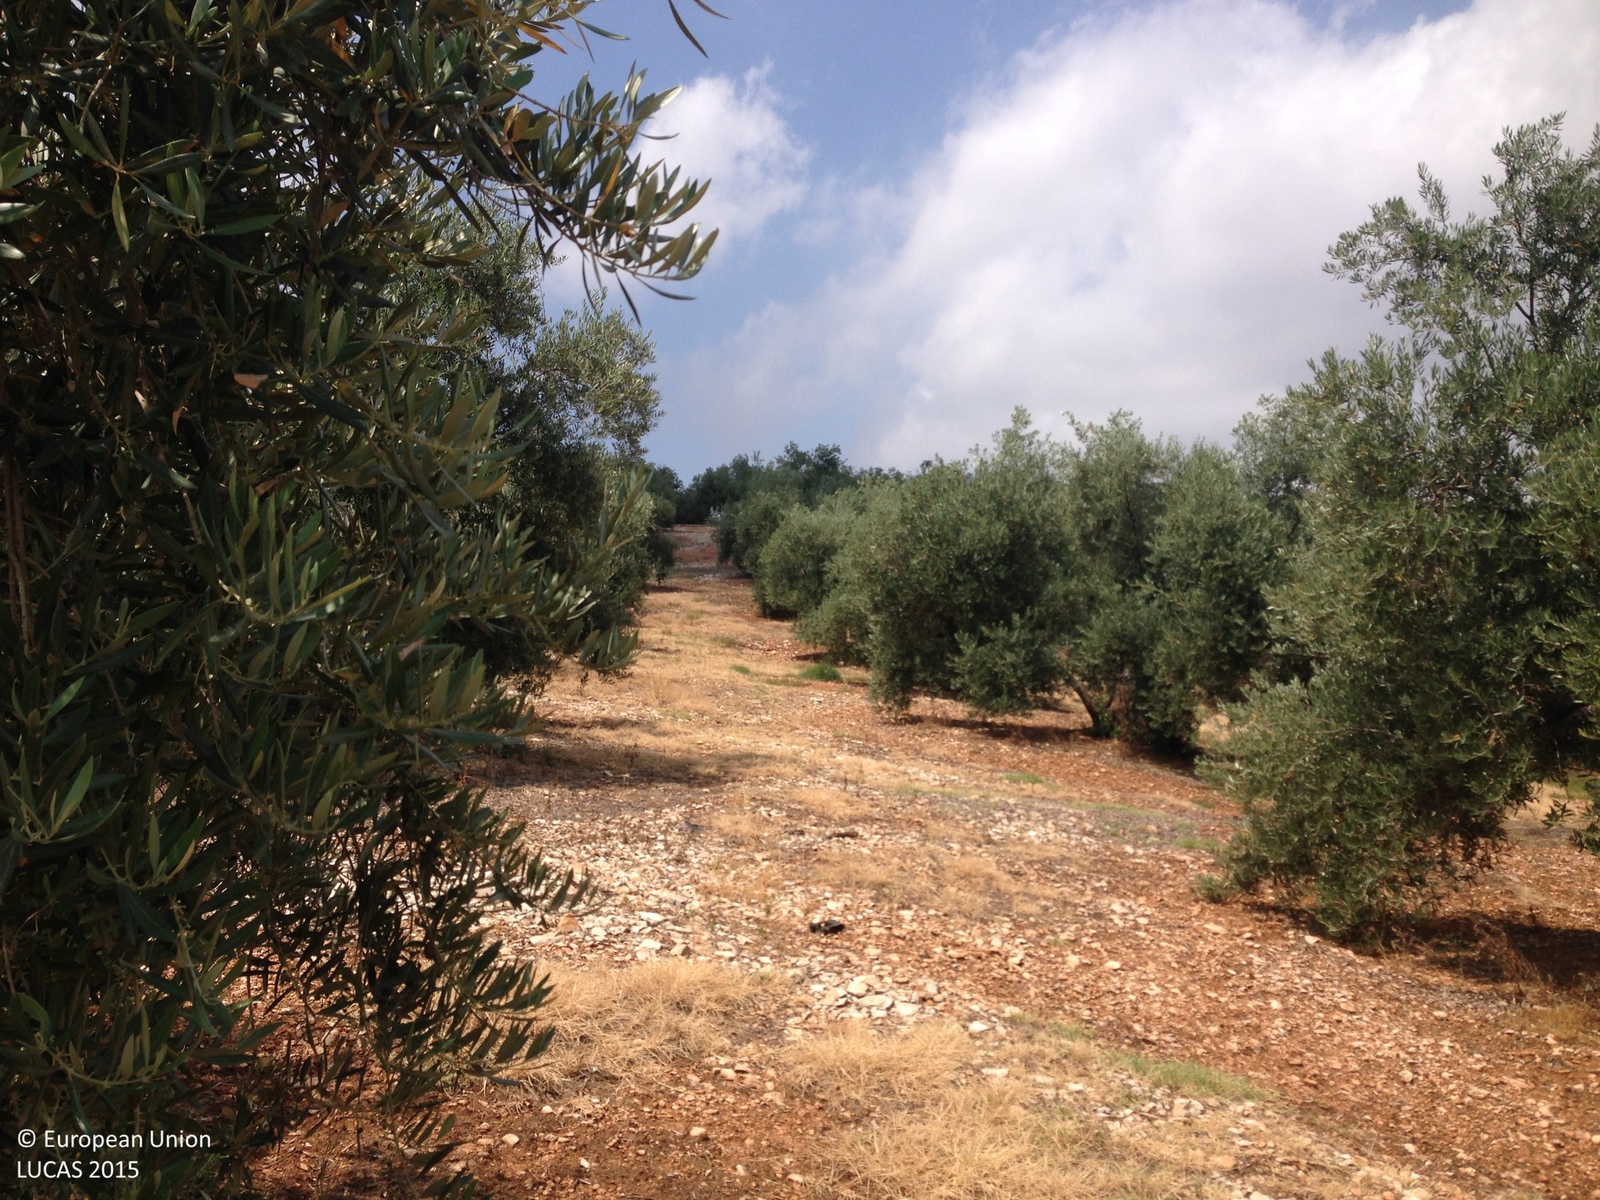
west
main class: Cropland
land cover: Olive groves
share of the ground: 25 - 50 %
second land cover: Other bare soil
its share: > 75 %
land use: Agriculture (excluding fallow land and kitchen gardens)
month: June
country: ES
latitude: 38.1657
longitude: -2.9068
